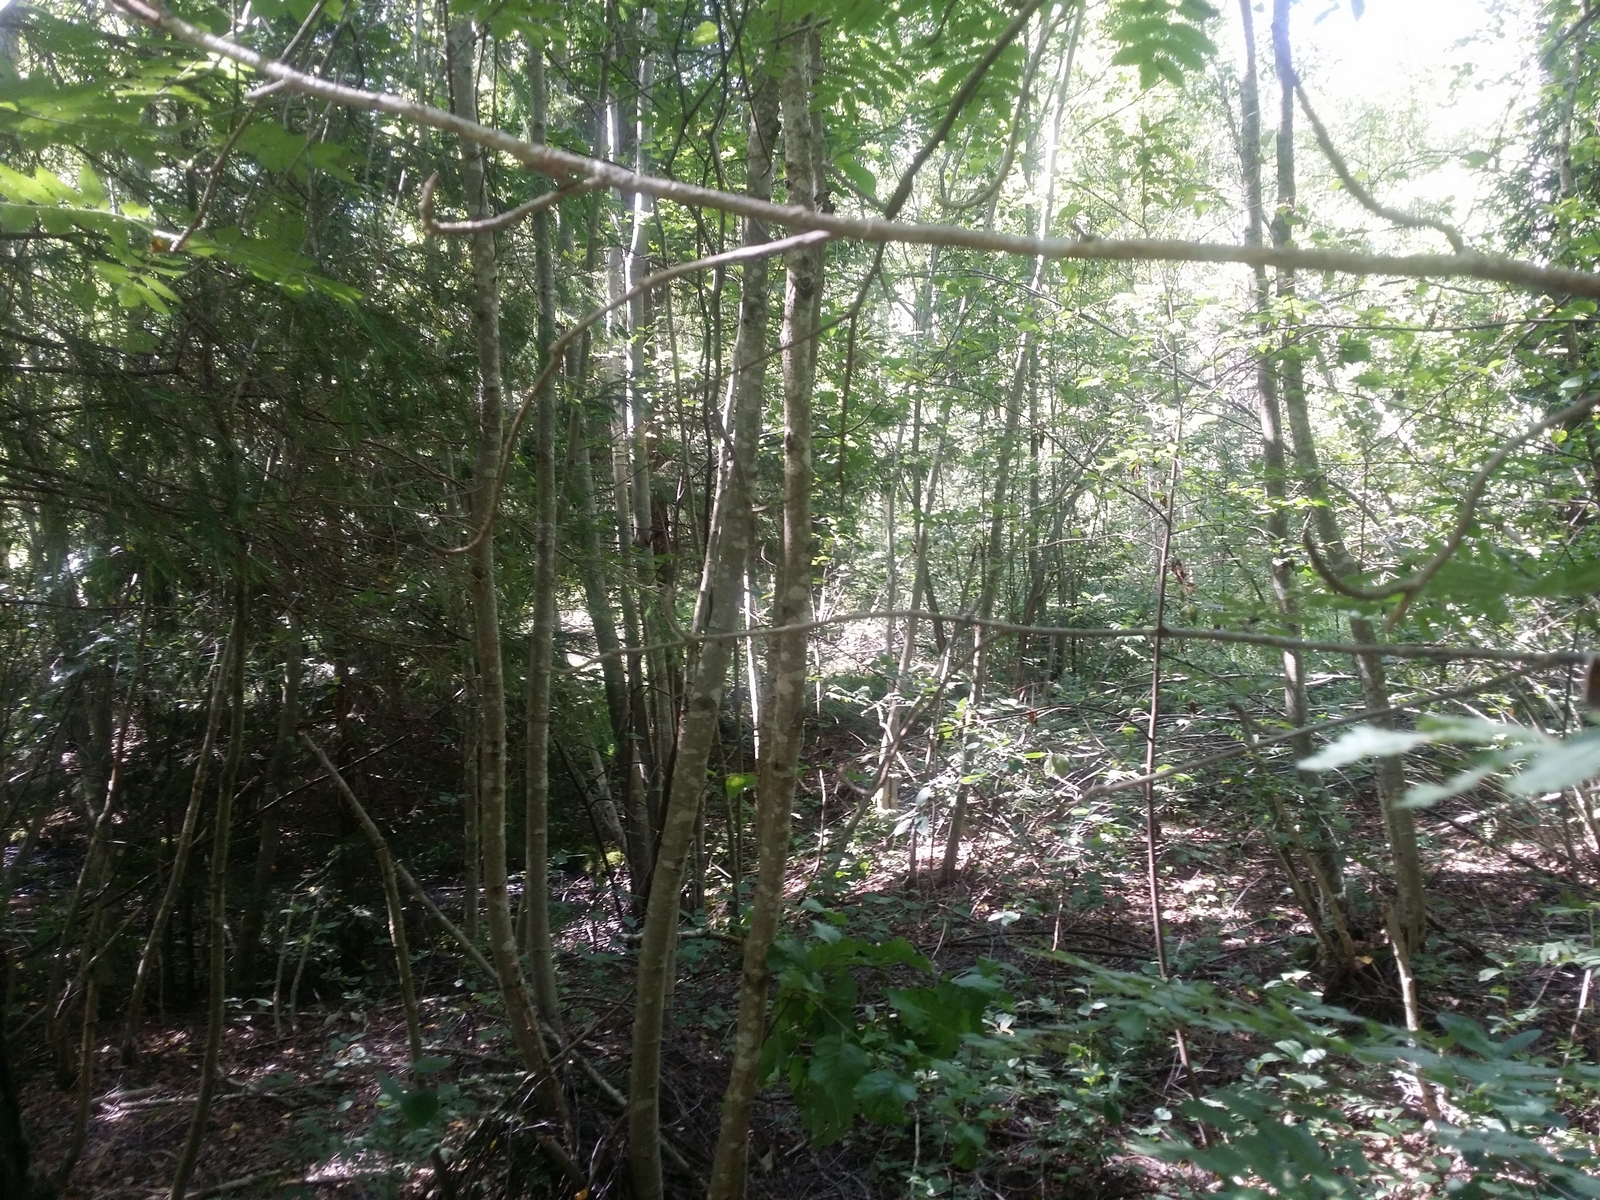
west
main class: Woodland
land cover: Broadleaved woodland
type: non-riverine alder, birch or aspen forest
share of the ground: > 75 %
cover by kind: broadleaved forest trees 80 %, coniferous forest trees 5 %, shrubs 5 %, herbaceous plants 5 %, lichens and mosses 5 %
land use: Forestry
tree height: > 5 m
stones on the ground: < 10 %
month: July
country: LV
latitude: 57.3109
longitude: 26.8383
